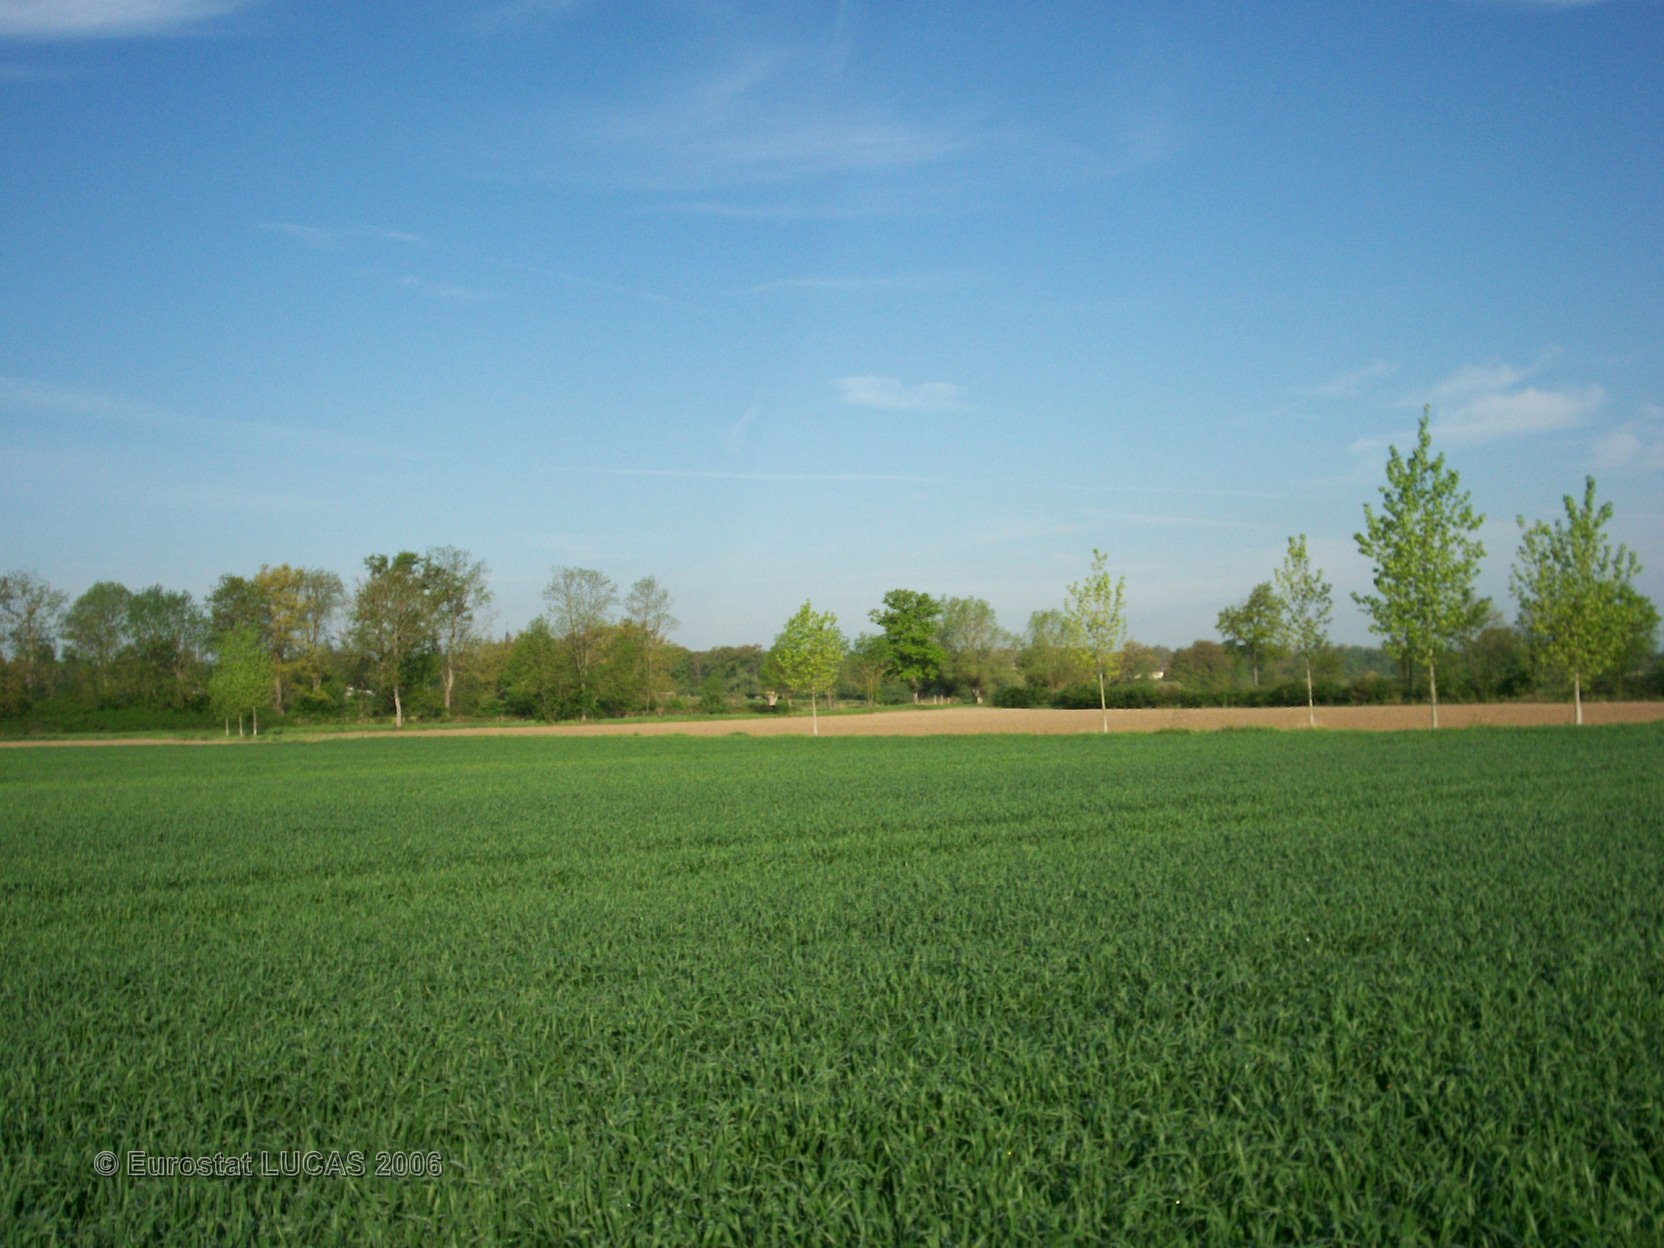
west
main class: Cropland
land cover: Common wheat
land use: Agriculture (excluding fallow land and kitchen gardens)
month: May
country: FR
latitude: 45.7951
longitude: 4.1746
